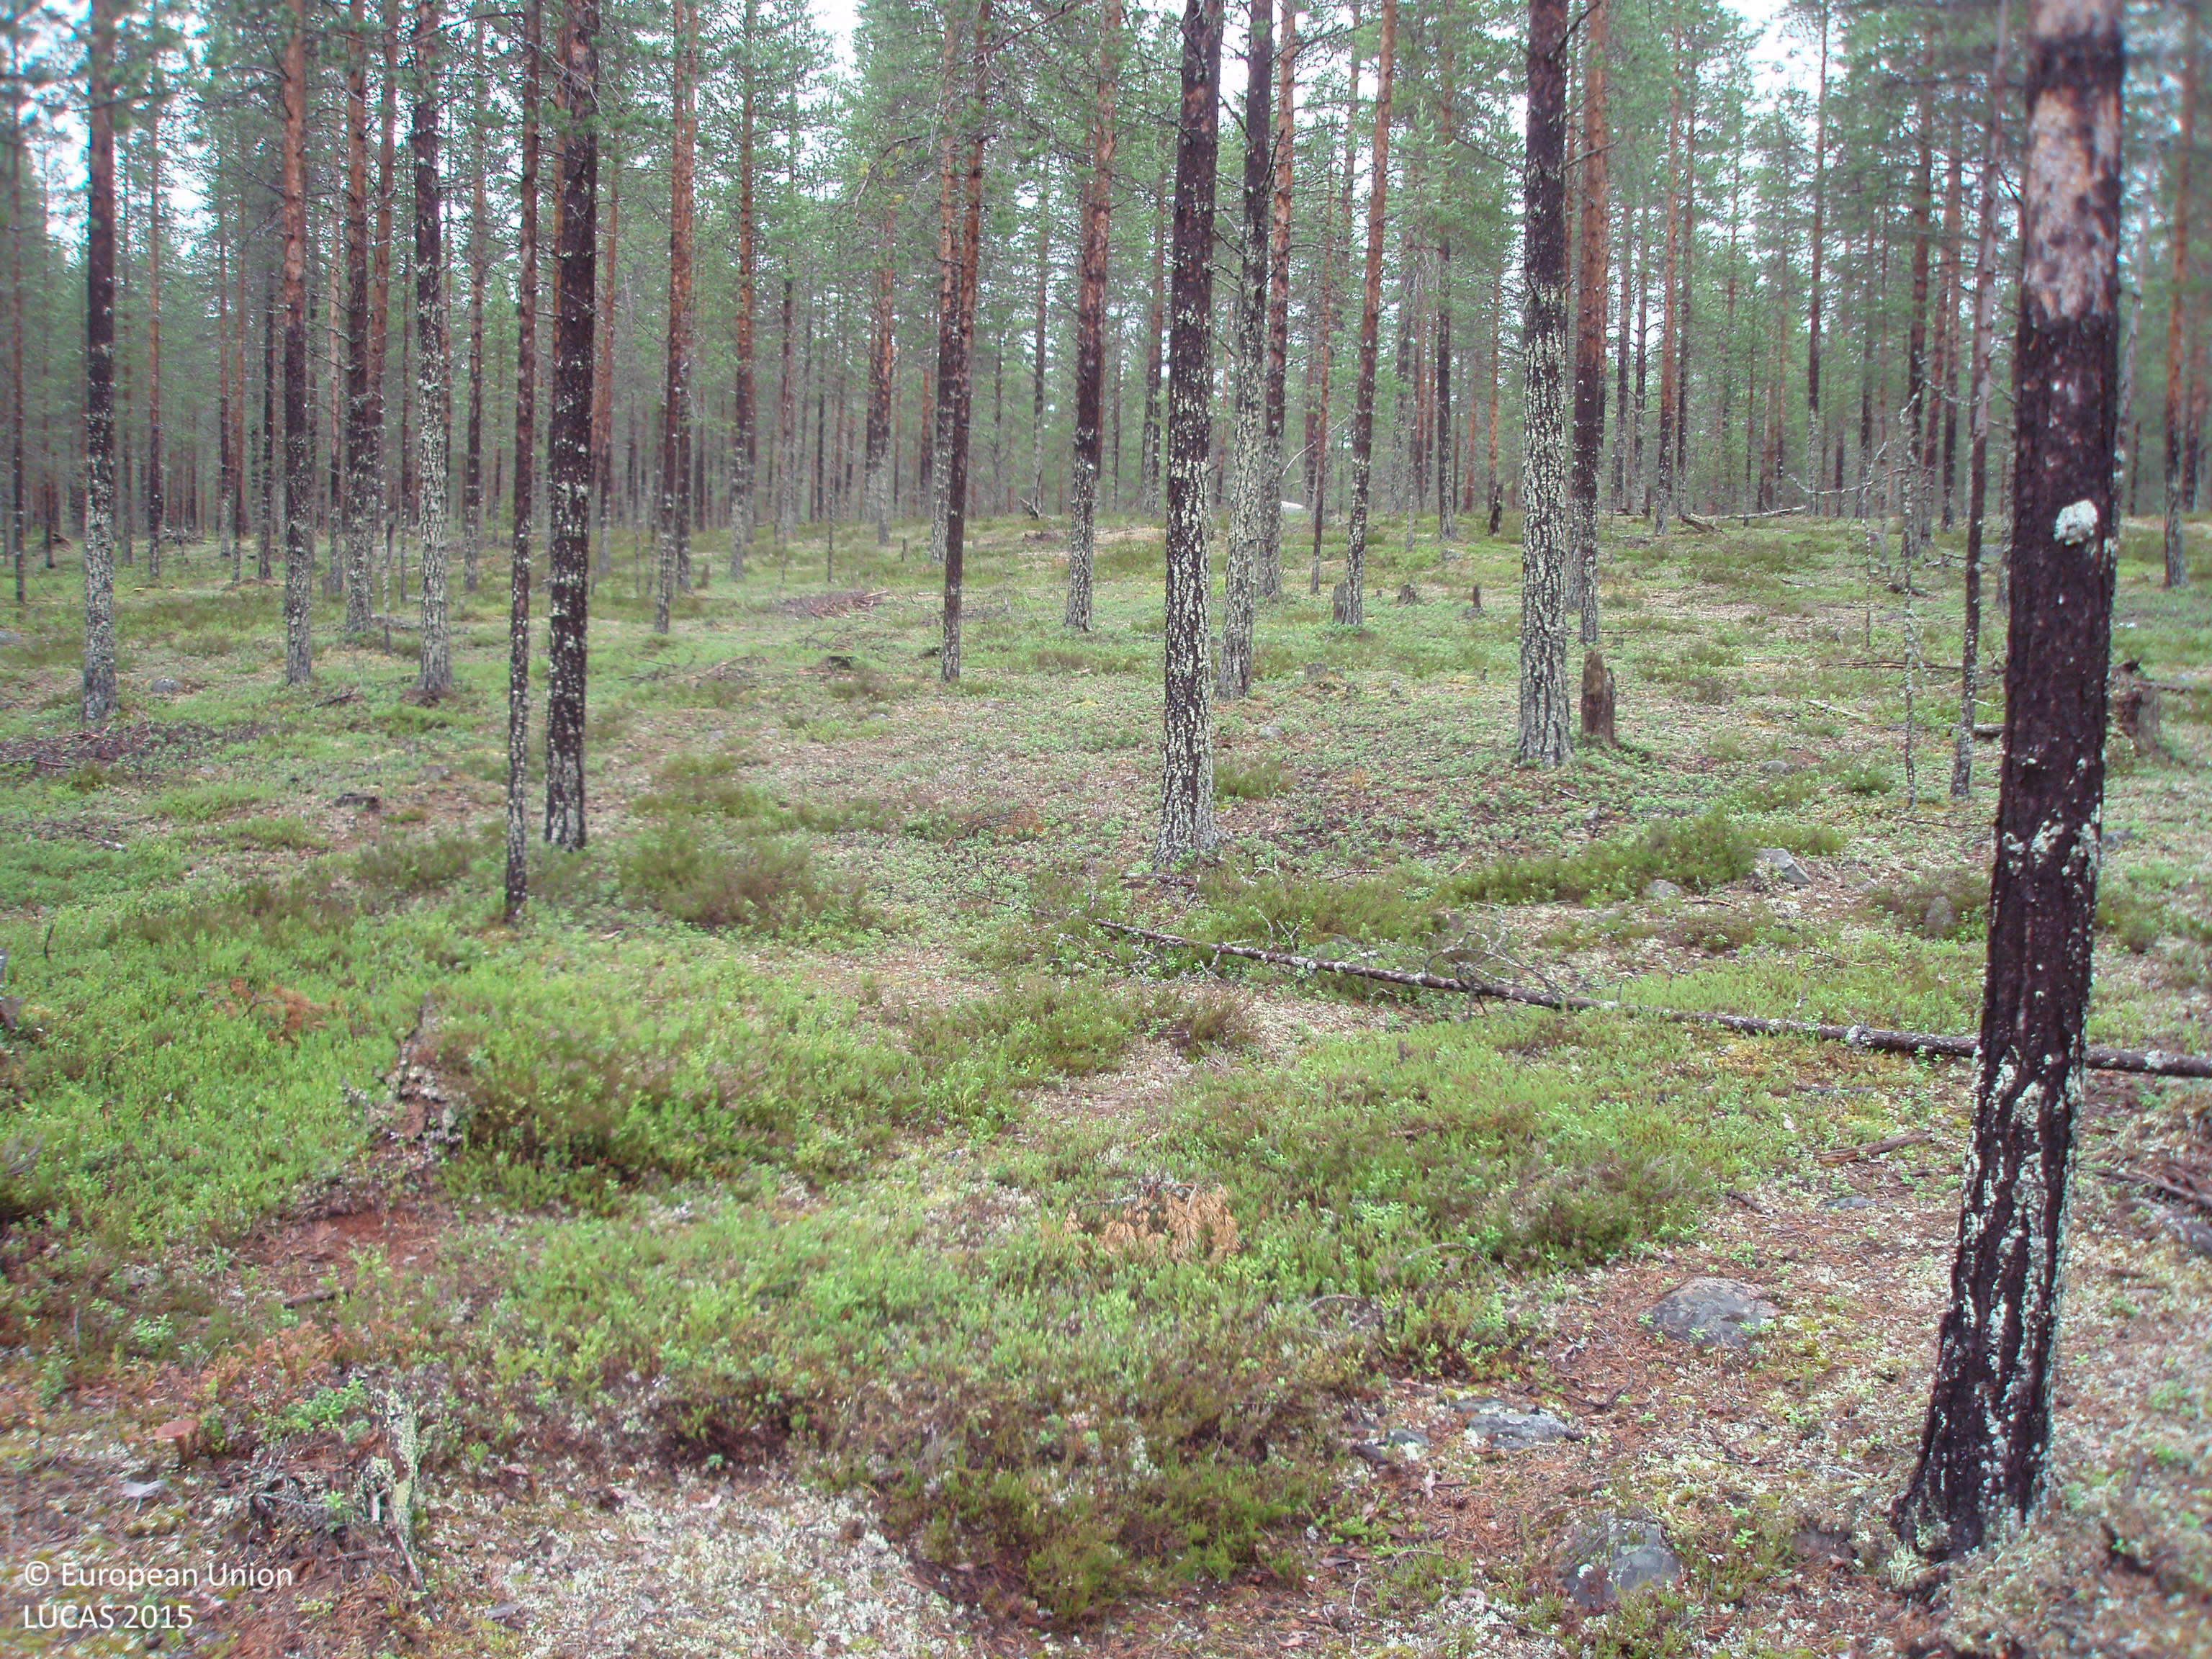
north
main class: Woodland
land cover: Pine dominated coniferous woodland
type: boreal forest
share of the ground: 50 - 75 %
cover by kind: coniferous forest trees 60 %, shrubs 30 %, lichens and mosses 10 %
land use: Forestry
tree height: > 5 m
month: July
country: FI
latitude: 65.9958
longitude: 27.9125
